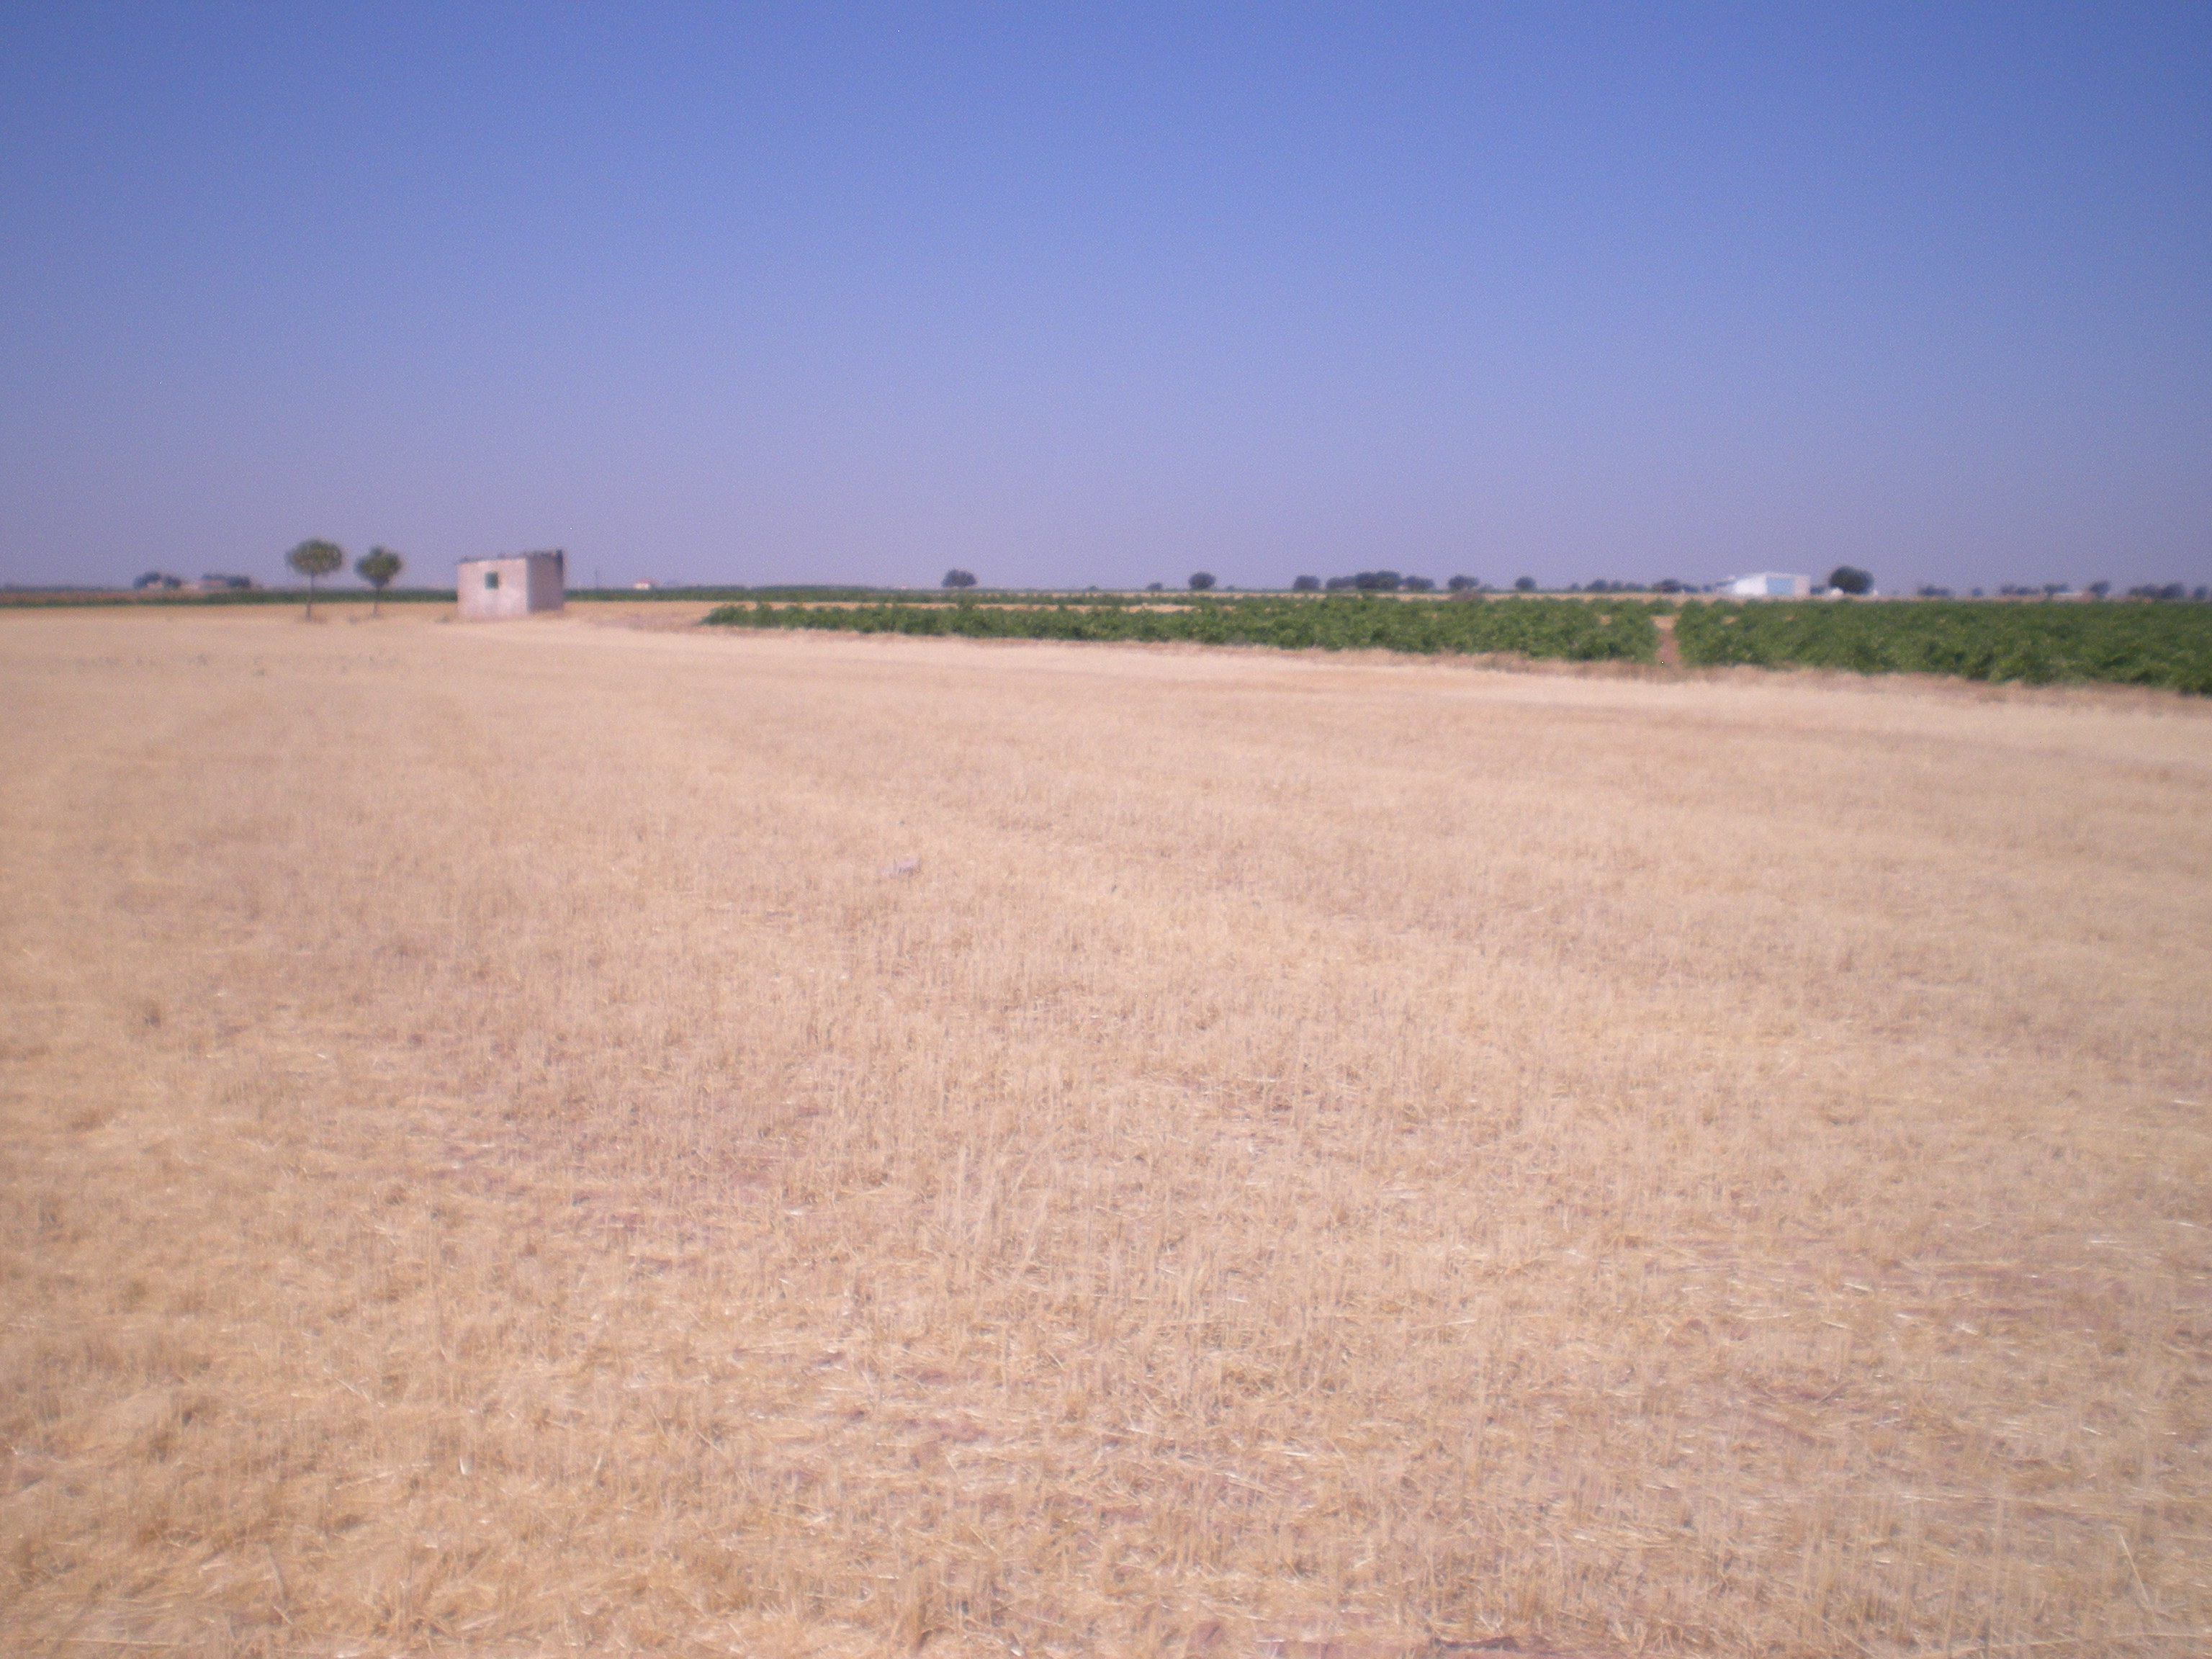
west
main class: Cropland
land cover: Barley
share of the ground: < 10 %
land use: Agriculture (excluding fallow land and kitchen gardens)
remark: Harvested field
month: July
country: ES
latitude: 39.3227
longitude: -3.0180
